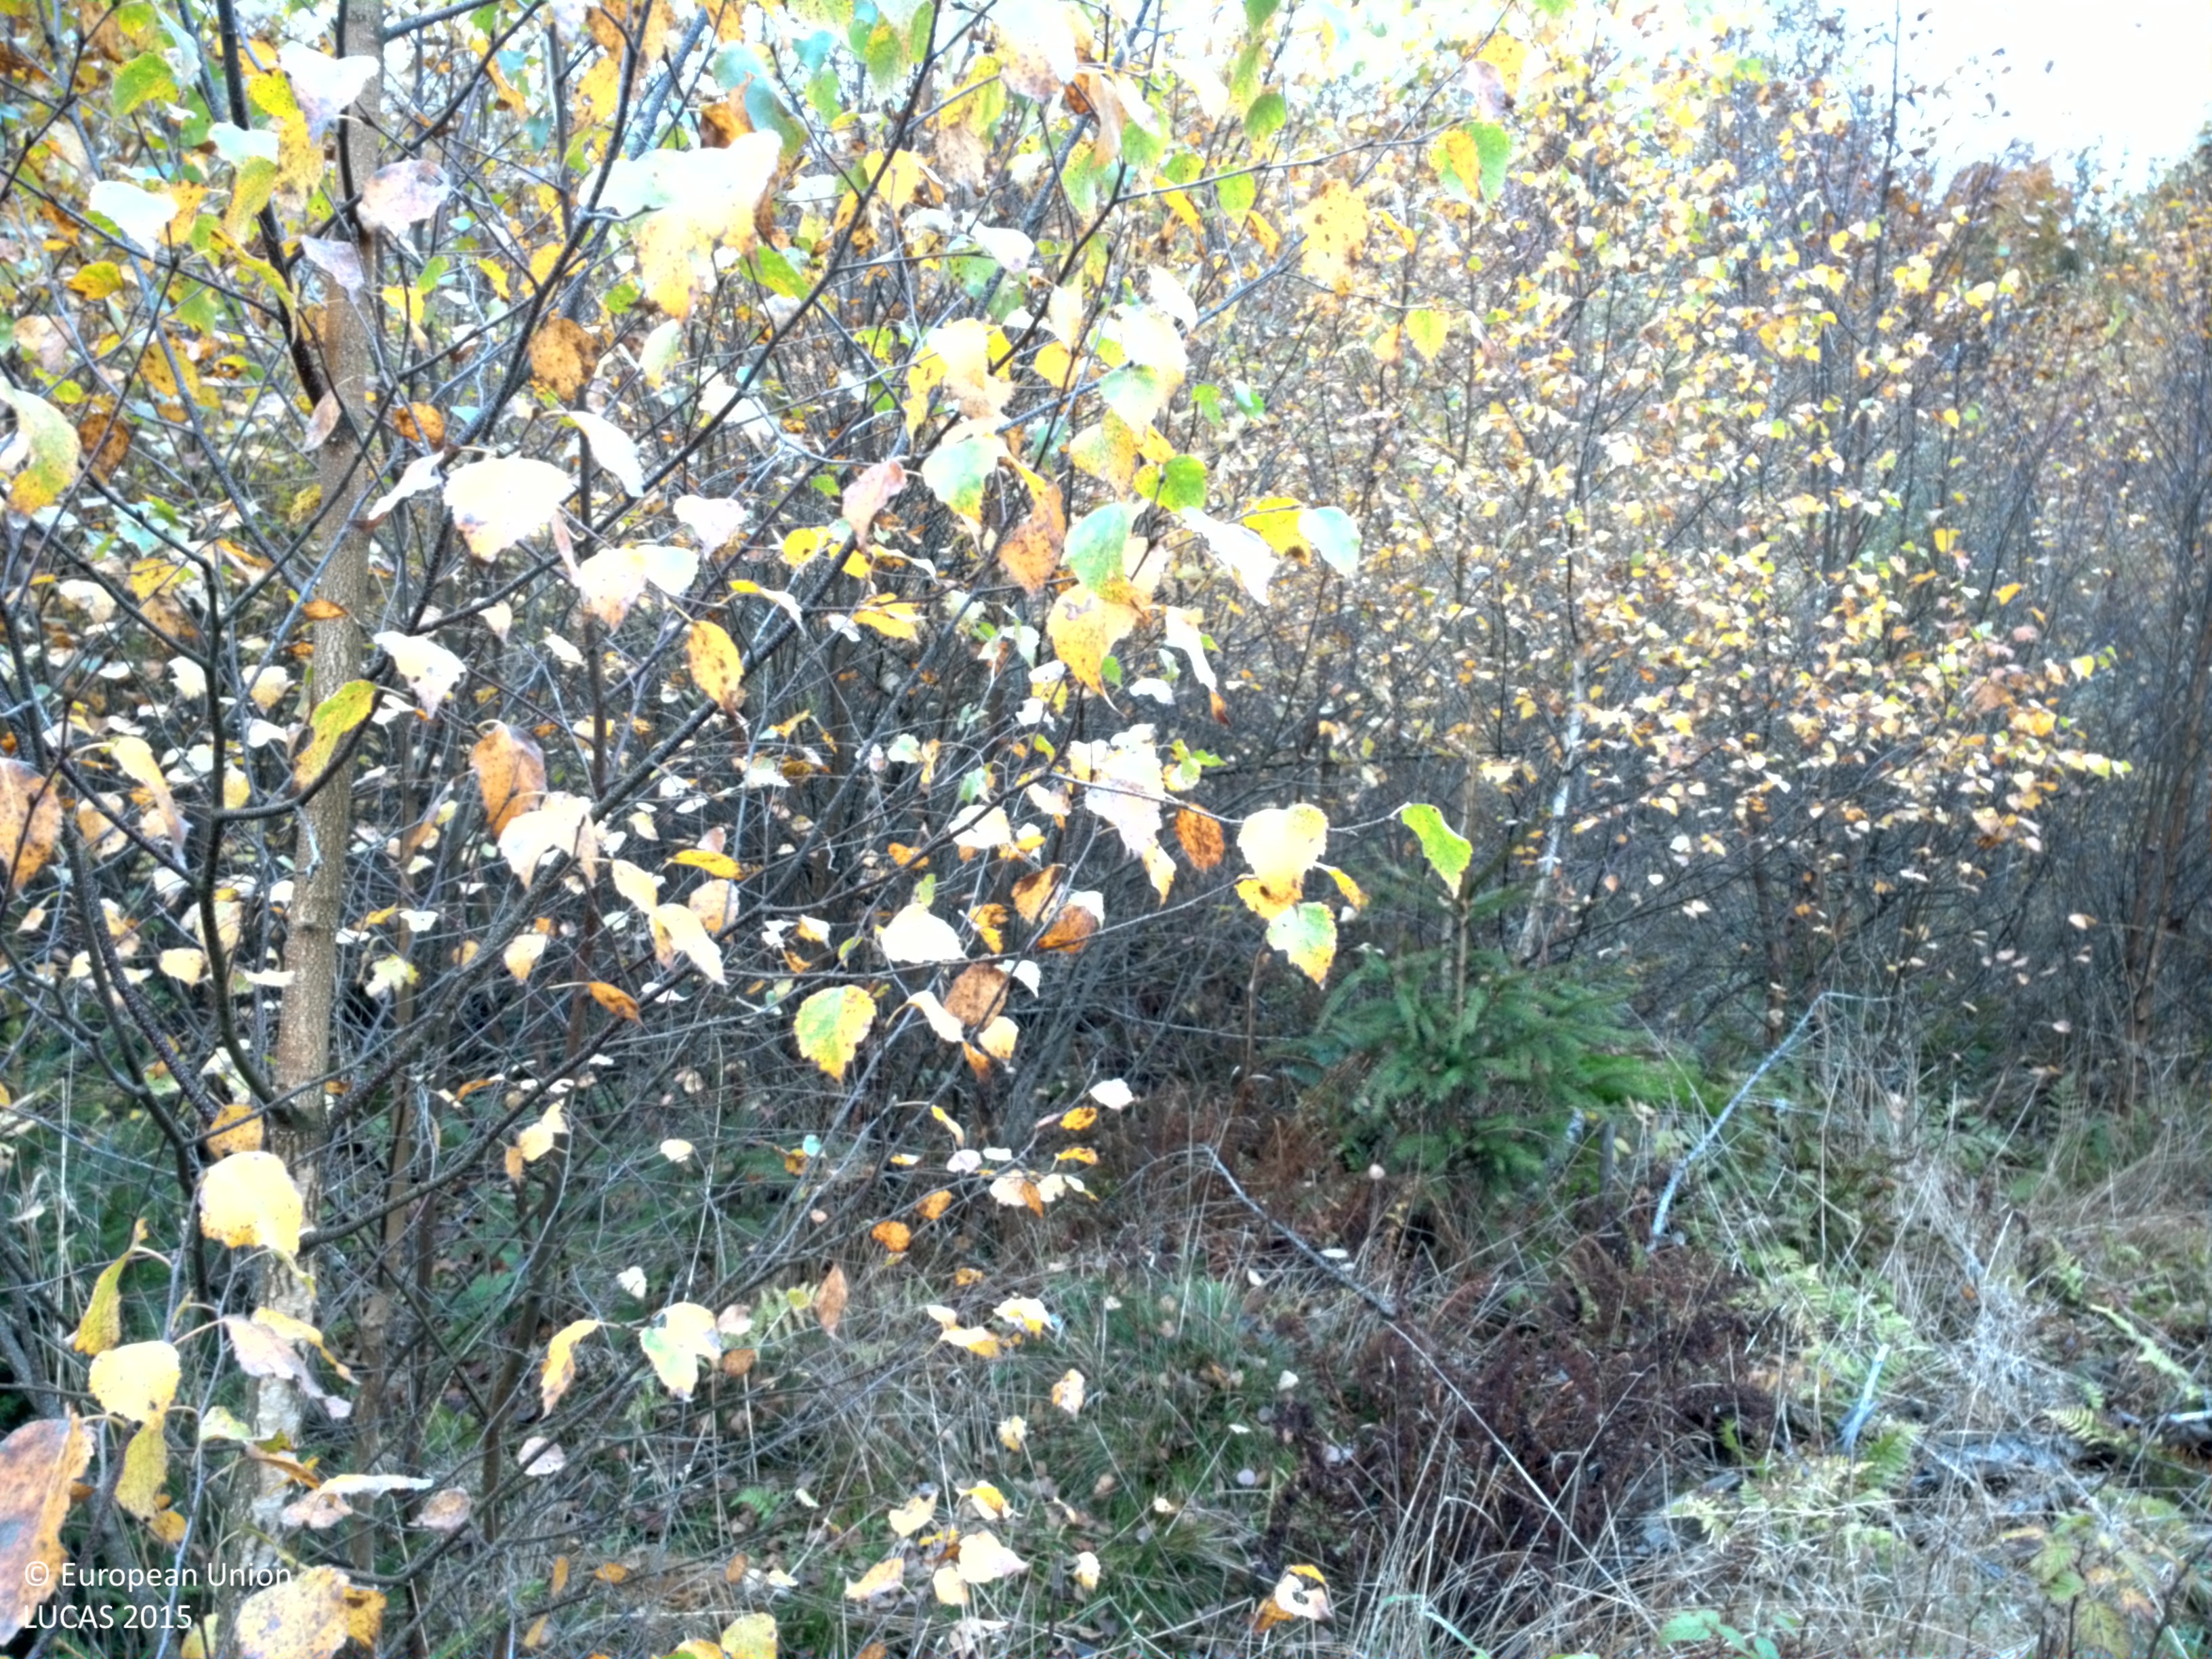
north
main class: Woodland
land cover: Other mixed woodland
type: hemiboreal forest and nemoral coniferous forest and mixed broadleaved-coniferous forest
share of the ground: 50 - 75 %
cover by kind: broadleaved forest trees 50 %, herbaceous plants 25 %, coniferous forest trees 20 %, shrubs 5 %
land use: Forestry
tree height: < 5 m
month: October
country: SE
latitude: 55.9367
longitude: 13.6958
